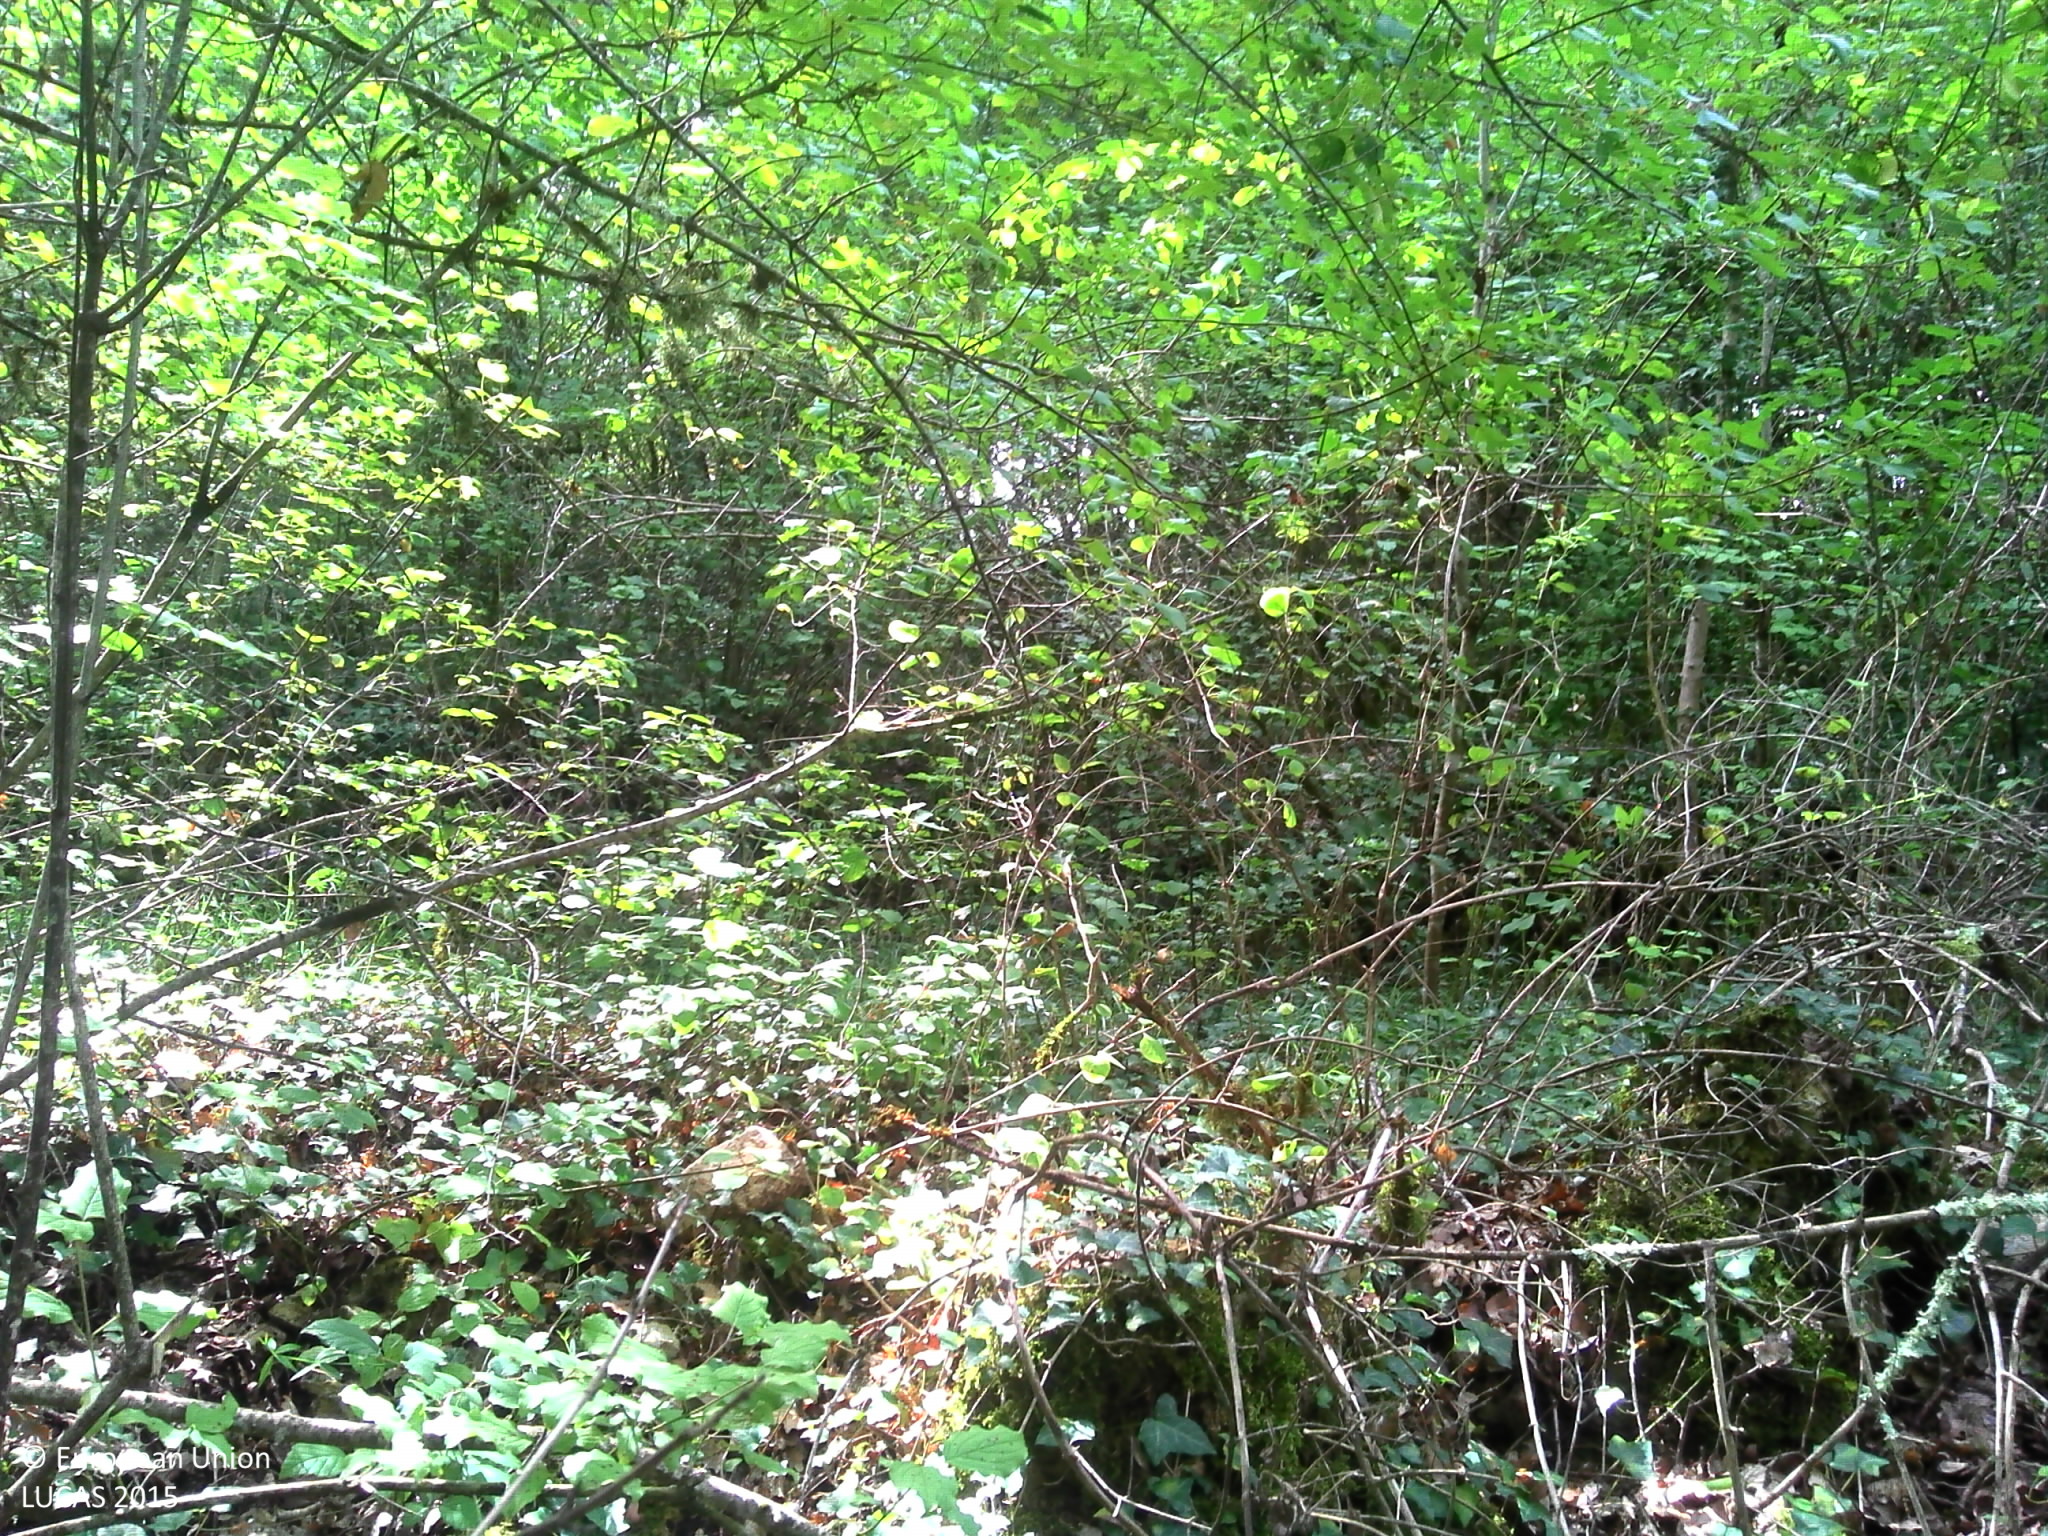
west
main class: Woodland
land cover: Broadleaved woodland
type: thermophilous deciduous forest
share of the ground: > 75 %
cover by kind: broadleaved forest trees 60 %, shrubs 30 %, herbaceous plants 5 %, lichens and mosses 5 %
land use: Agriculture (excluding fallow land and kitchen gardens)
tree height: > 5 m
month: September
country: FR
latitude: 44.5803
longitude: 1.2688
